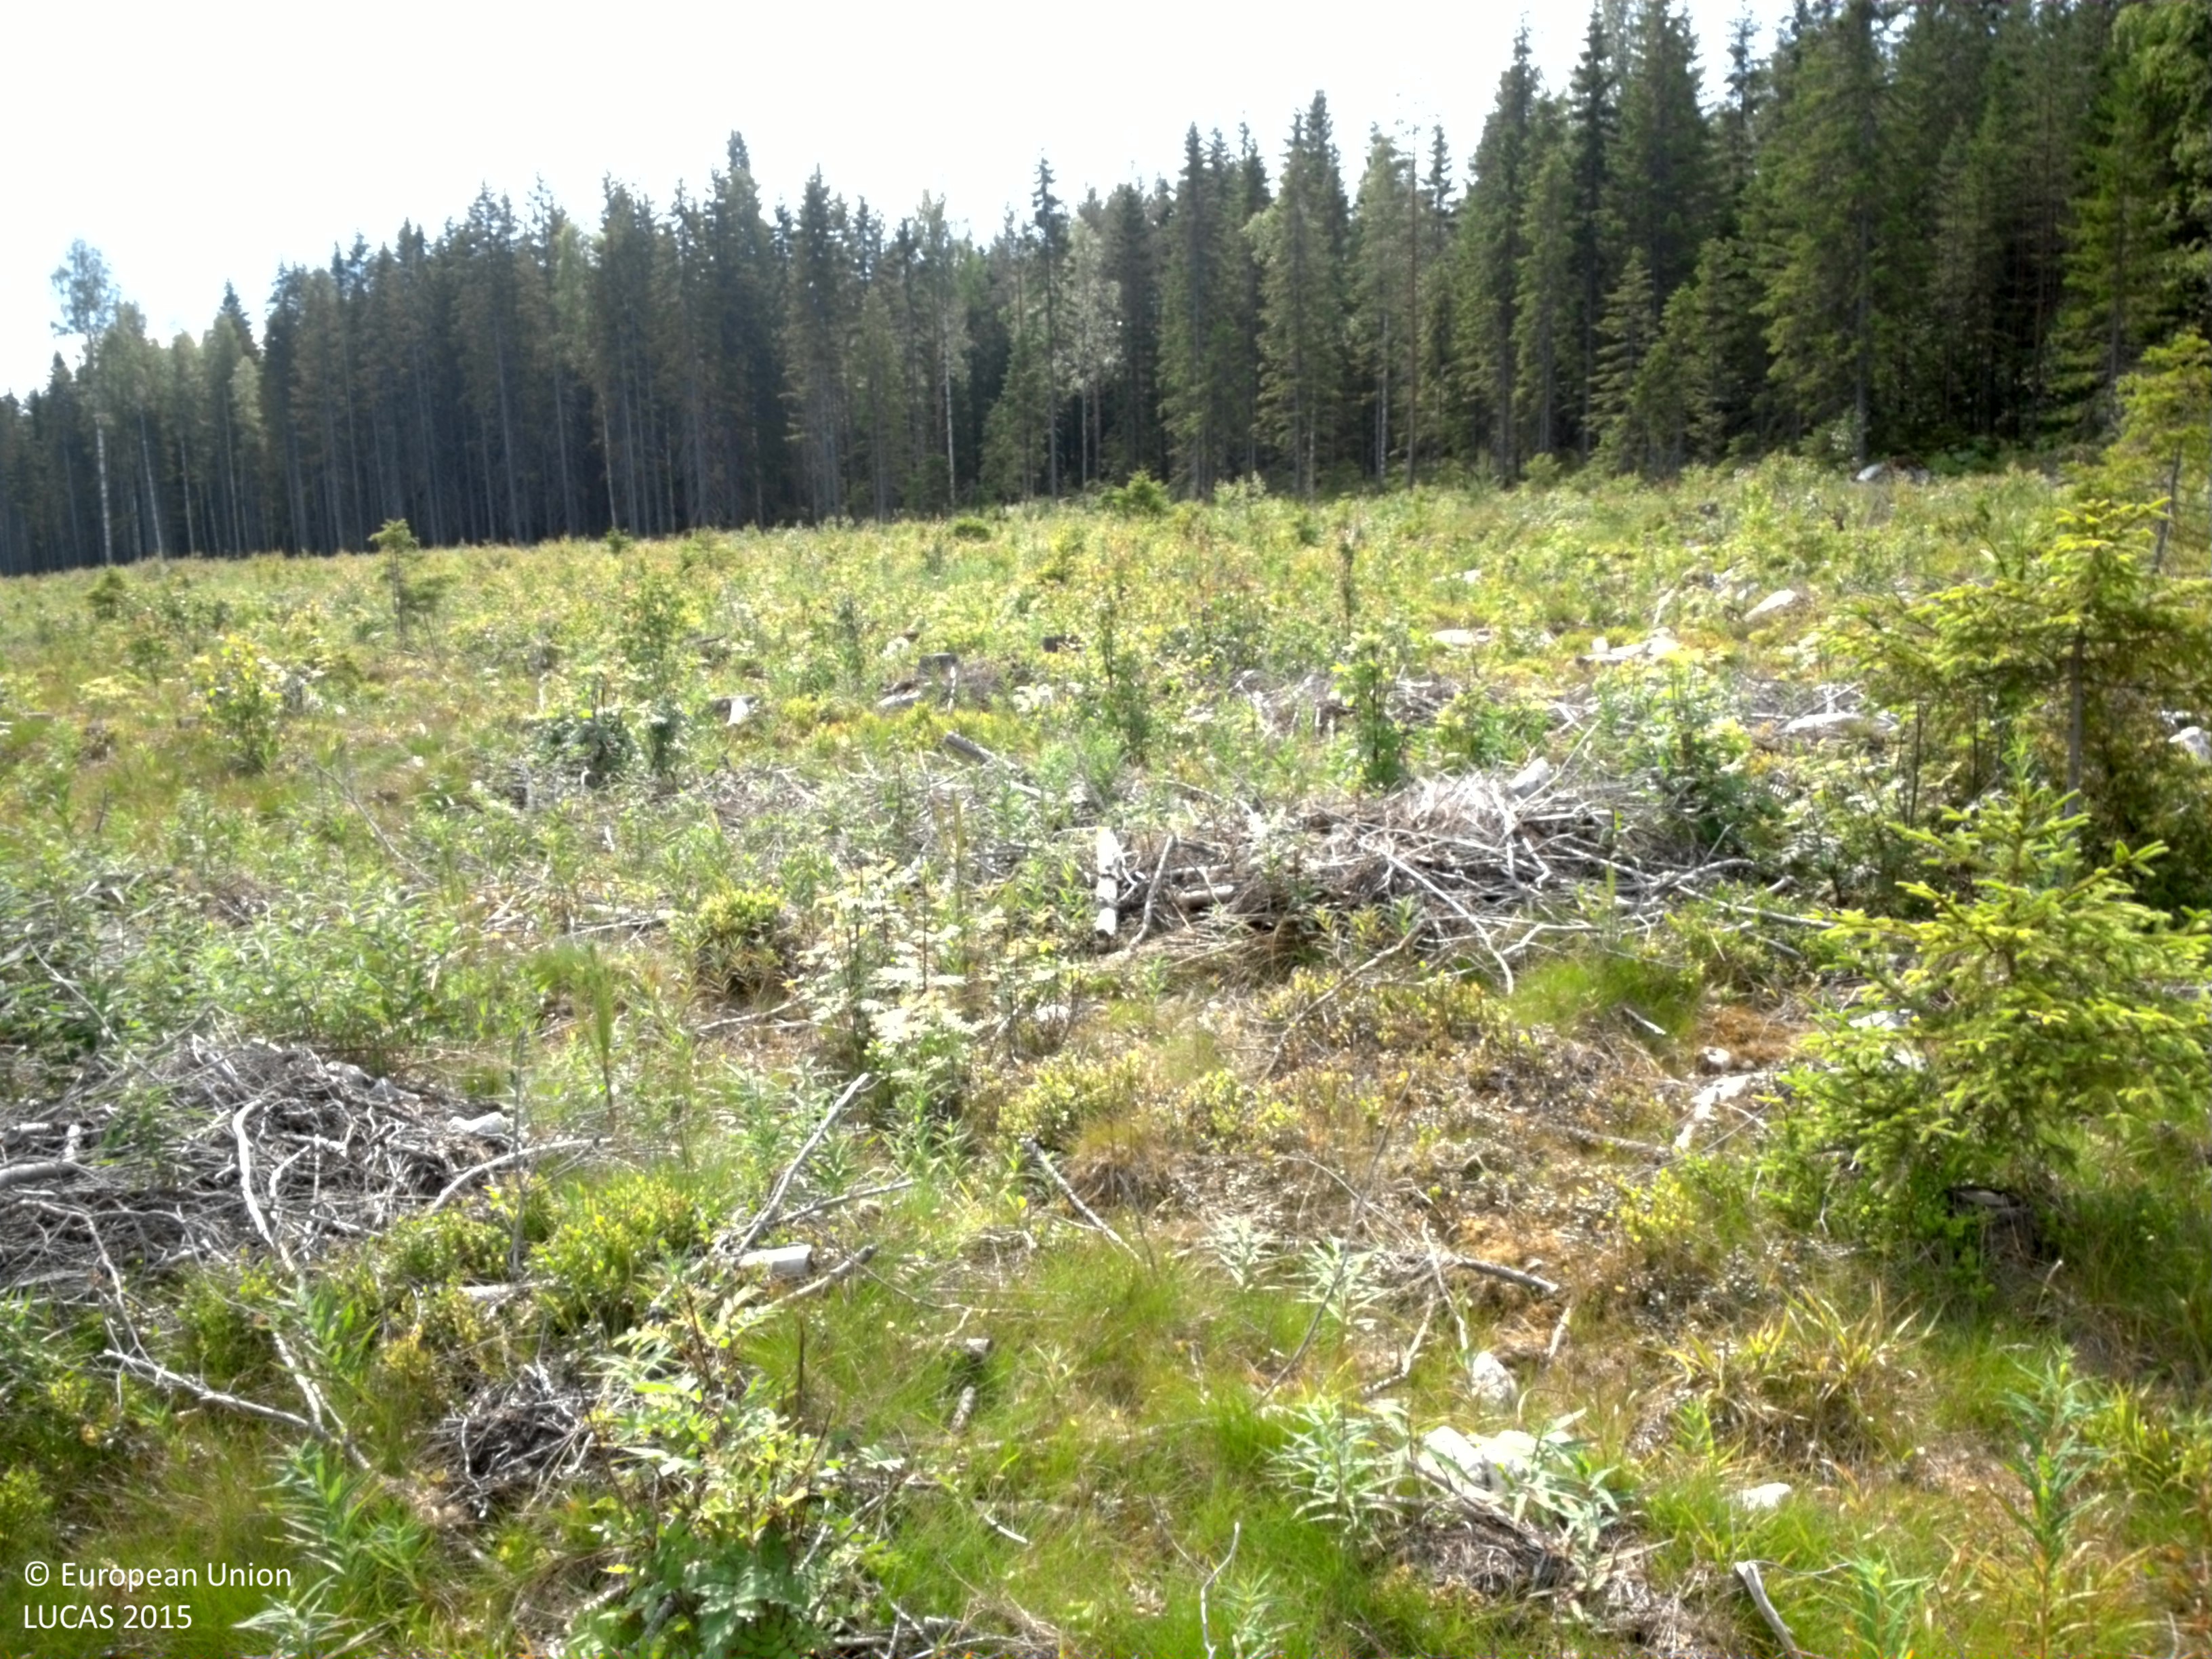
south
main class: Grassland
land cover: Grassland with sparse tree/shrub cover
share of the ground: > 75 %
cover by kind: herbaceous plants 75 %, shrubs 10 %, unconsolidated bare surface 10 %, broadleaved forest trees 5 %
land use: Forestry
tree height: > 5 m
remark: Clear cut
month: July
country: SE
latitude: 64.4400
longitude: 20.9283
